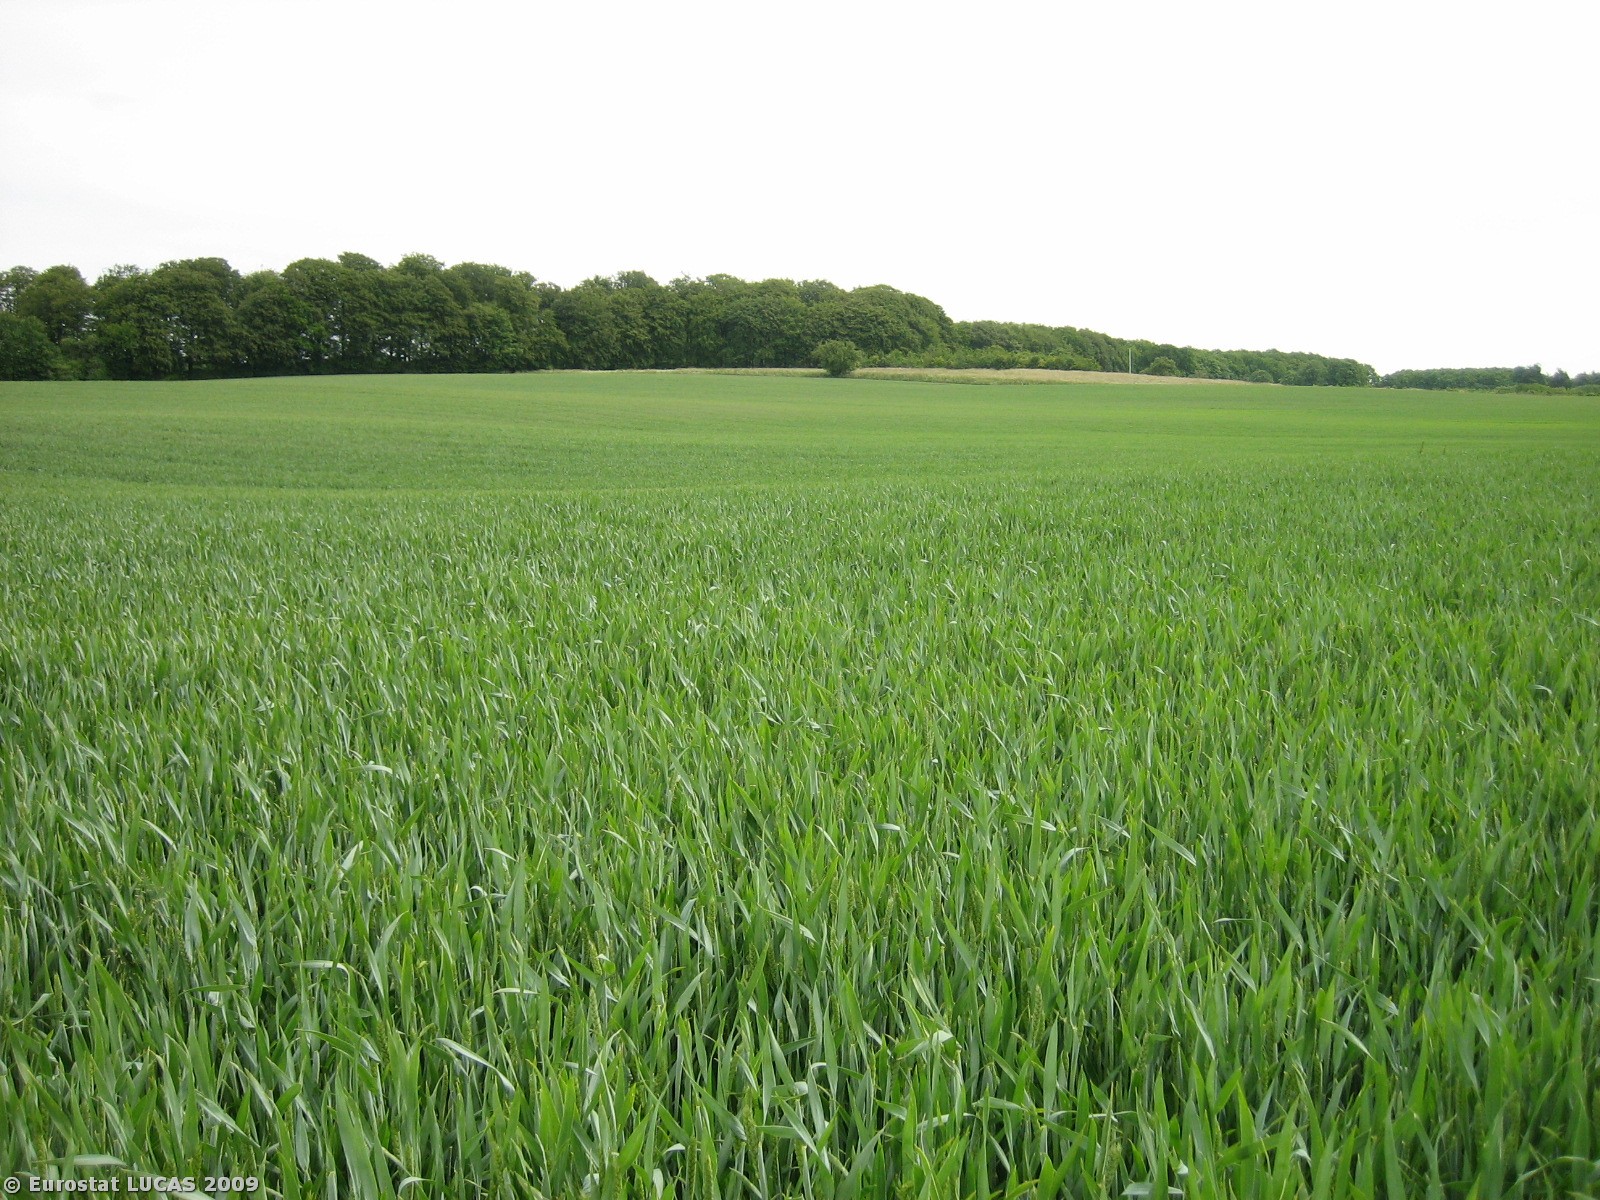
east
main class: Cropland
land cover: Common wheat
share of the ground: > 75 %
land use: Agriculture (excluding fallow land and kitchen gardens)
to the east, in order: Common wheat
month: June
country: DK
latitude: 56.2596
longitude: 10.0161
